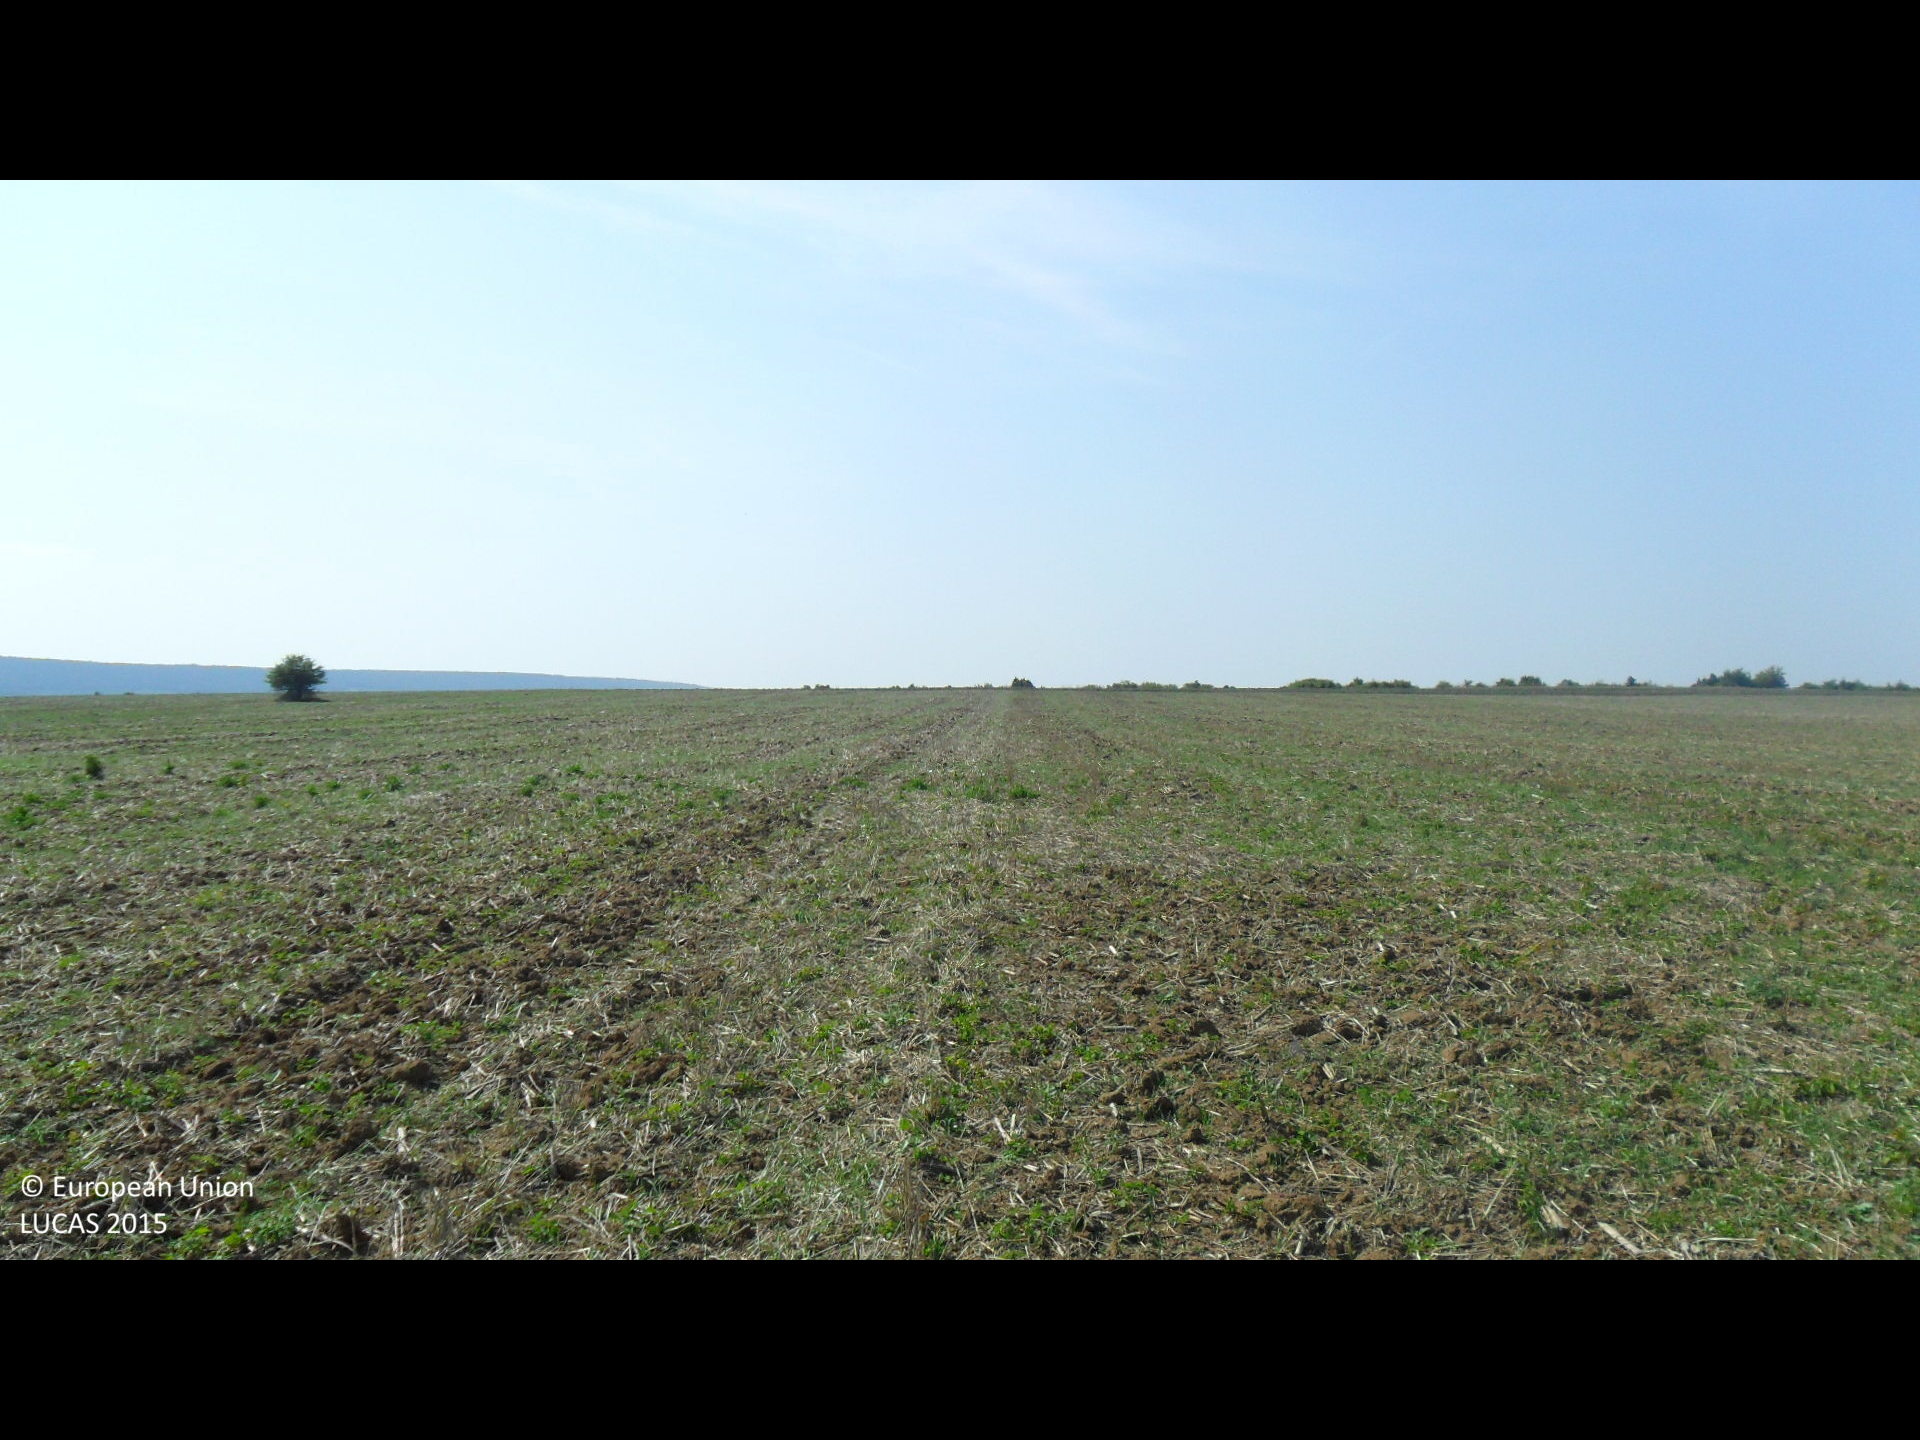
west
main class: Cropland
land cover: Common wheat
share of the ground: < 10 %
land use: Agriculture (excluding fallow land and kitchen gardens)
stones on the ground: < 10 %
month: September
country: BG
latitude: 43.0994
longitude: 26.6788
